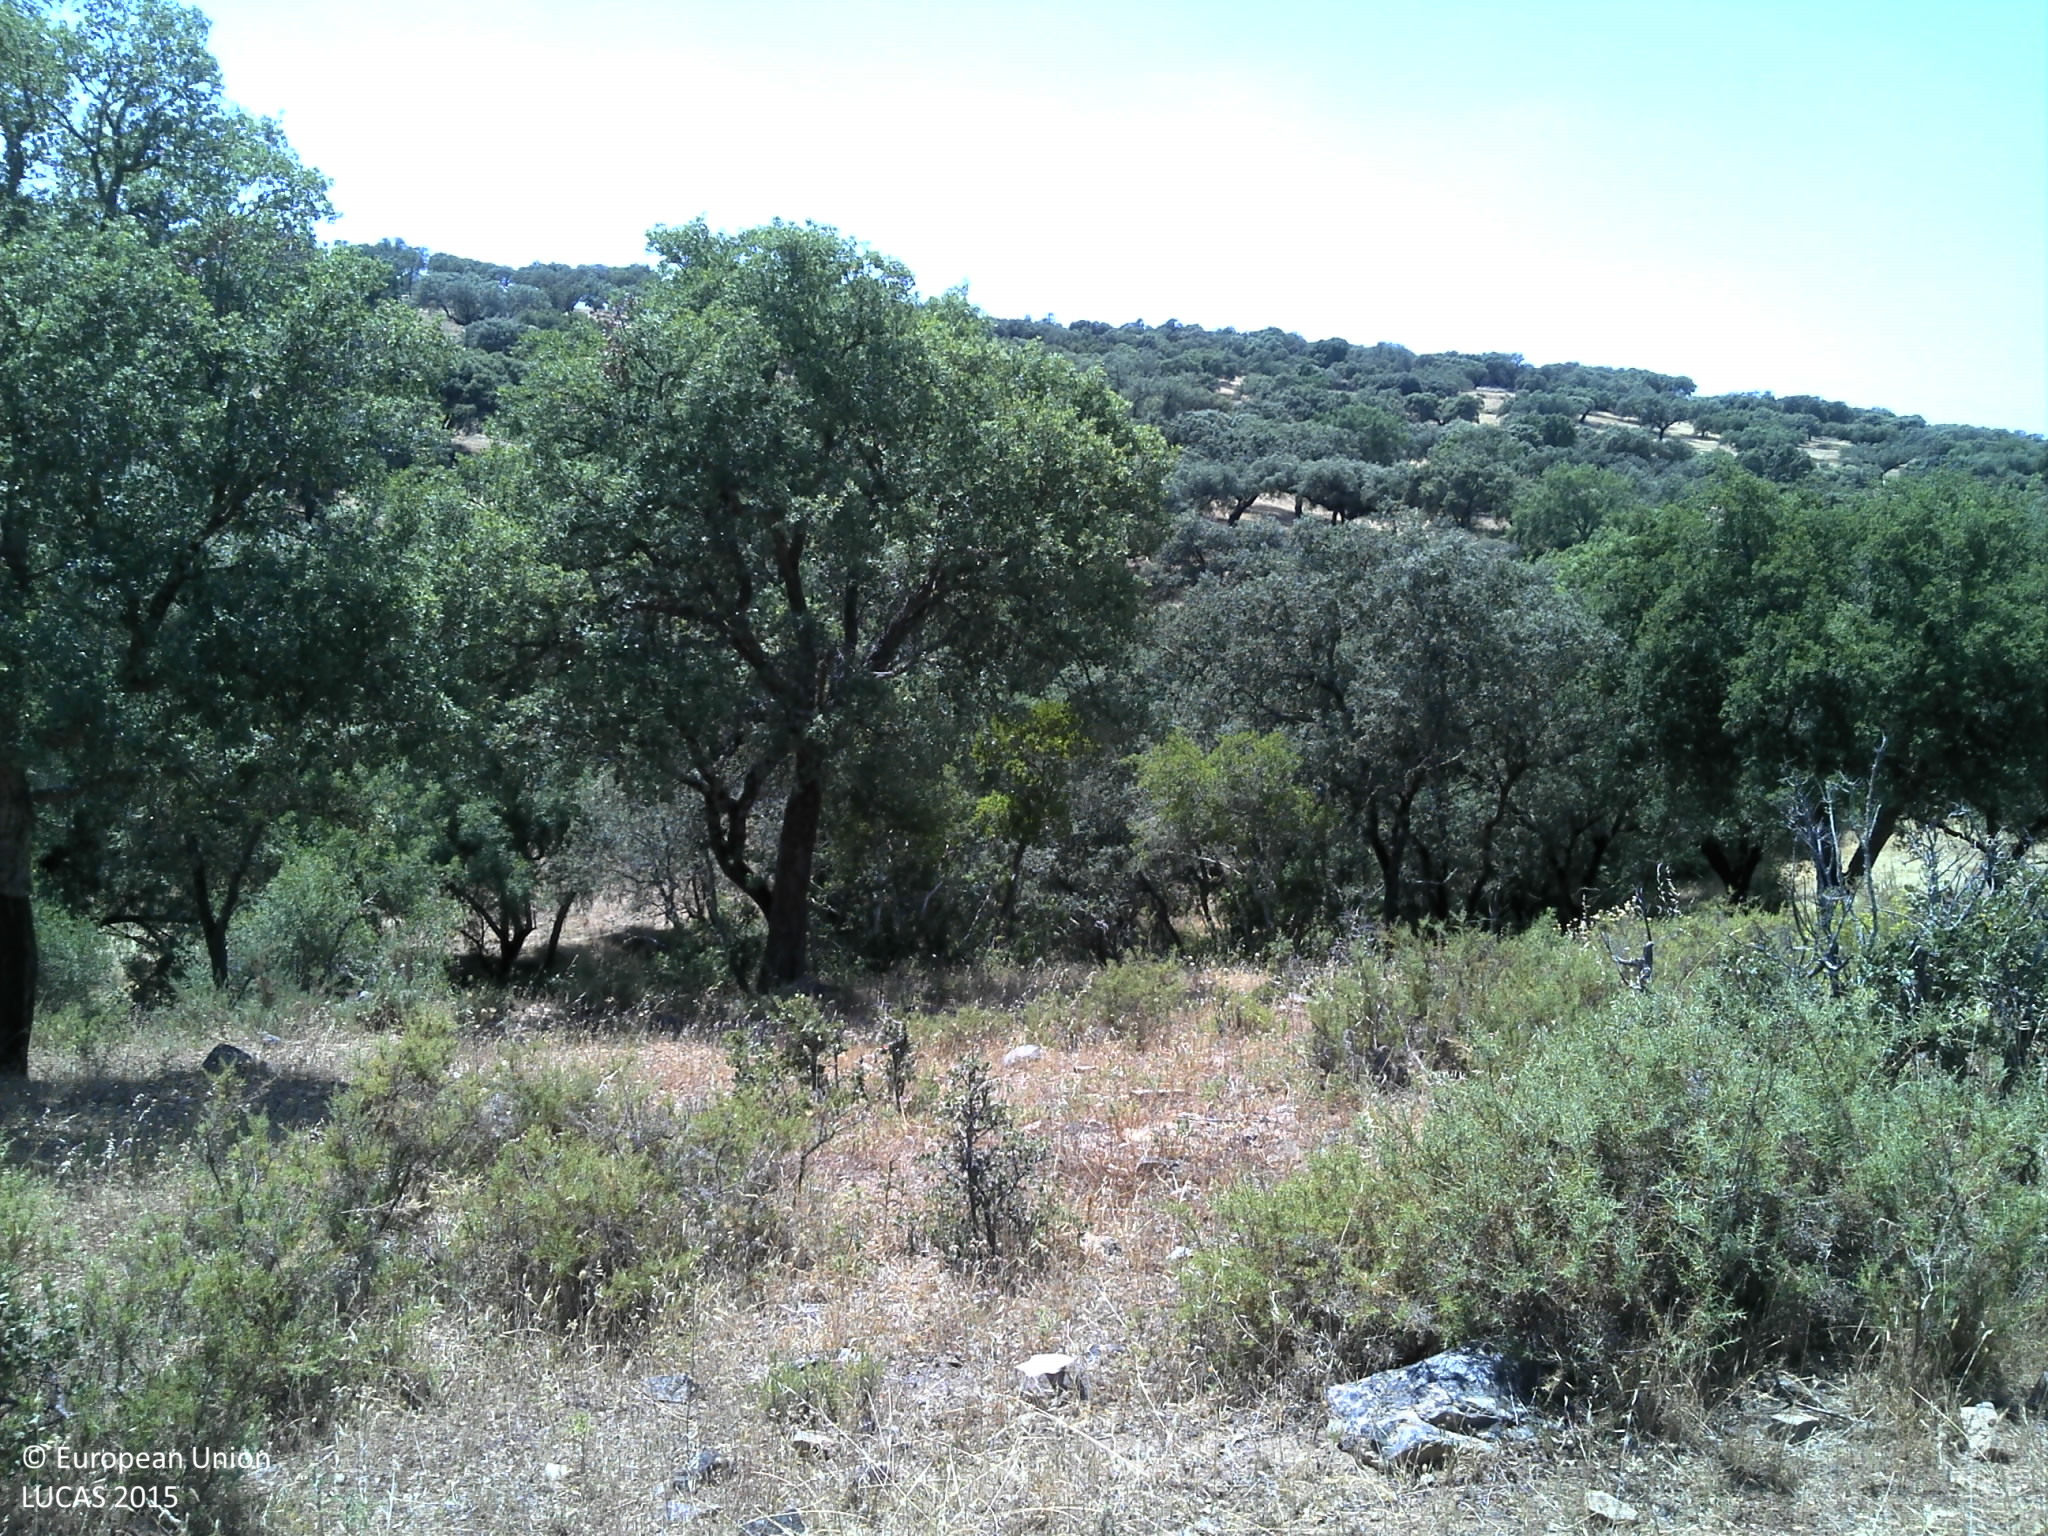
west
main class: Woodland
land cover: Broadleaved woodland
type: broadleaved evergreen forest
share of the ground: 25 - 50 %
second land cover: Shrubland without tree cover
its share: 25 - 50 %
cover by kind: shrubs 50 %, broadleaved forest trees 25 %, unconsolidated bare surface 15 %, herbaceous plants 10 %
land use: Forestry
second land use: Agriculture (excluding fallow land and kitchen gardens)
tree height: > 5 m
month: June
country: PT
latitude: 38.4239
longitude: -8.1754
